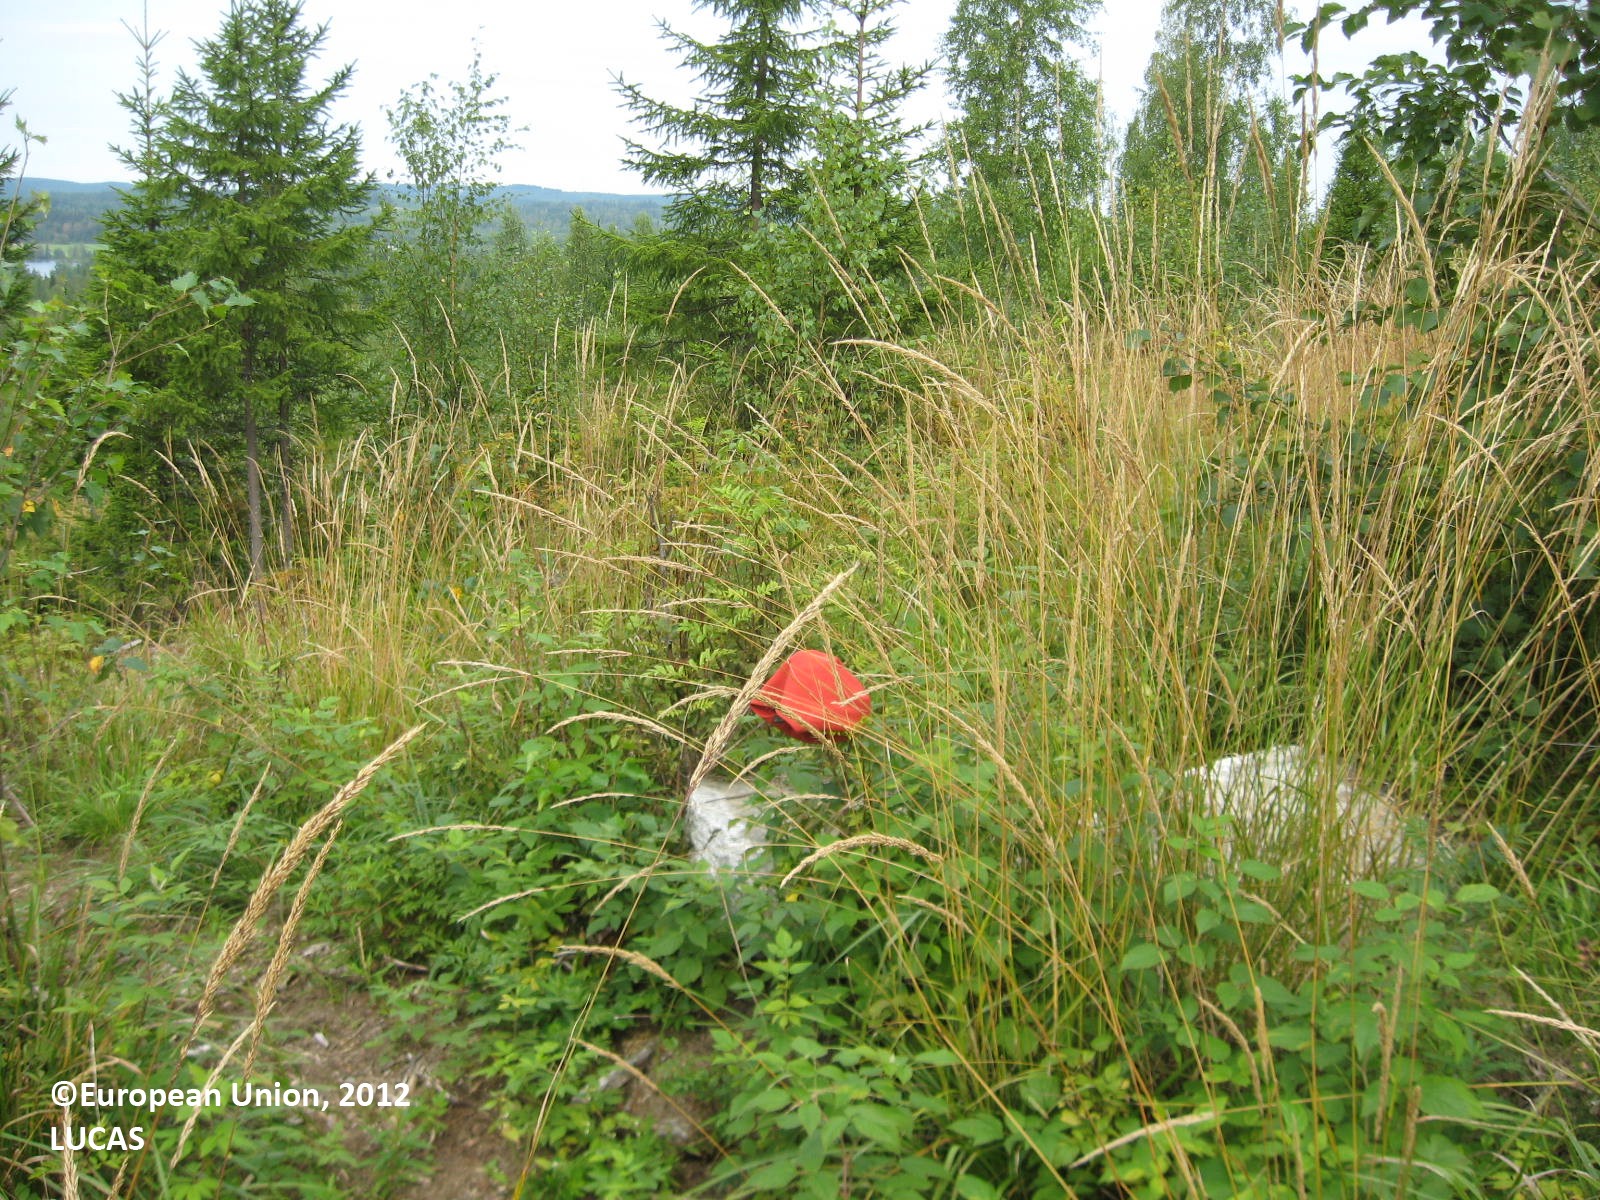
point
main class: Woodland
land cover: Other mixed woodland
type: boreal forest
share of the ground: 50 - 75 %
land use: Forestry
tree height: < 5 m
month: August
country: FI
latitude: 63.4439
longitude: 29.5361
